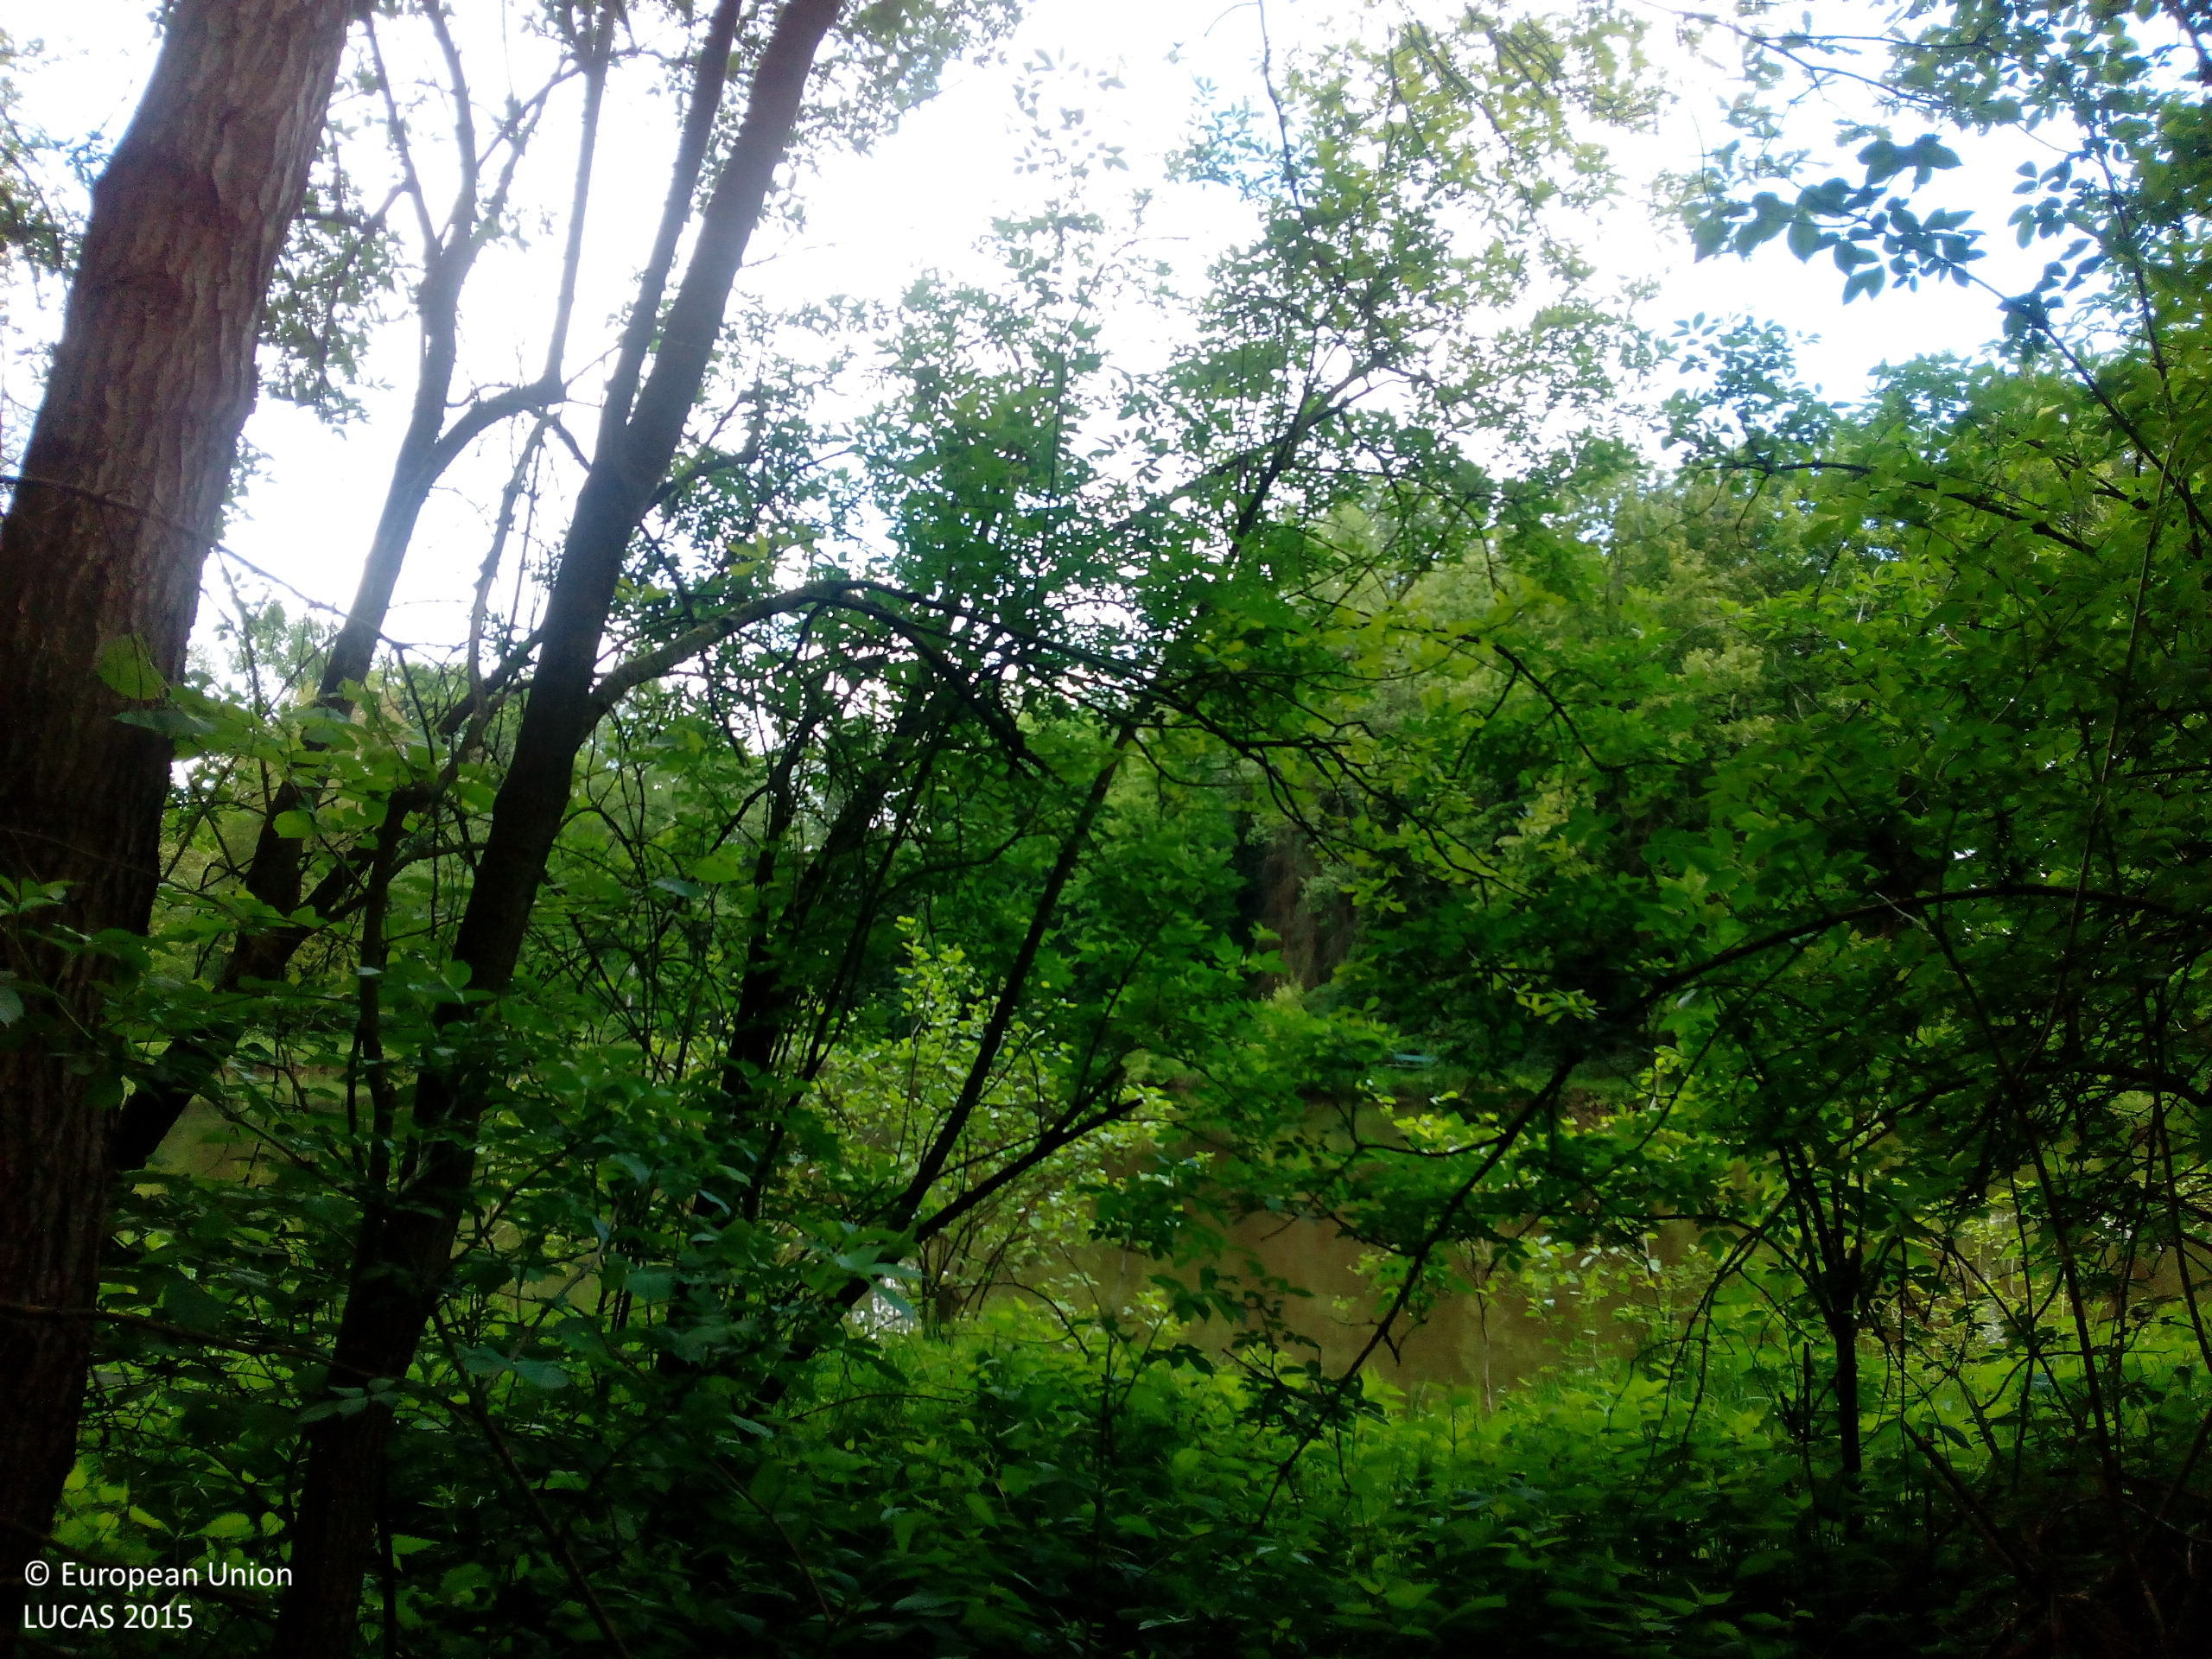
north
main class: Woodland
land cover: Other mixed woodland
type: mire and swamp forests
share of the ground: > 75 %
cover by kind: coniferous forest trees 45 %, broadleaved forest trees 40 %, herbaceous plants 10 %, shrubs 5 %
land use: Forestry
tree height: > 5 m
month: May
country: DE
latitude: 52.2240
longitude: 7.4385
